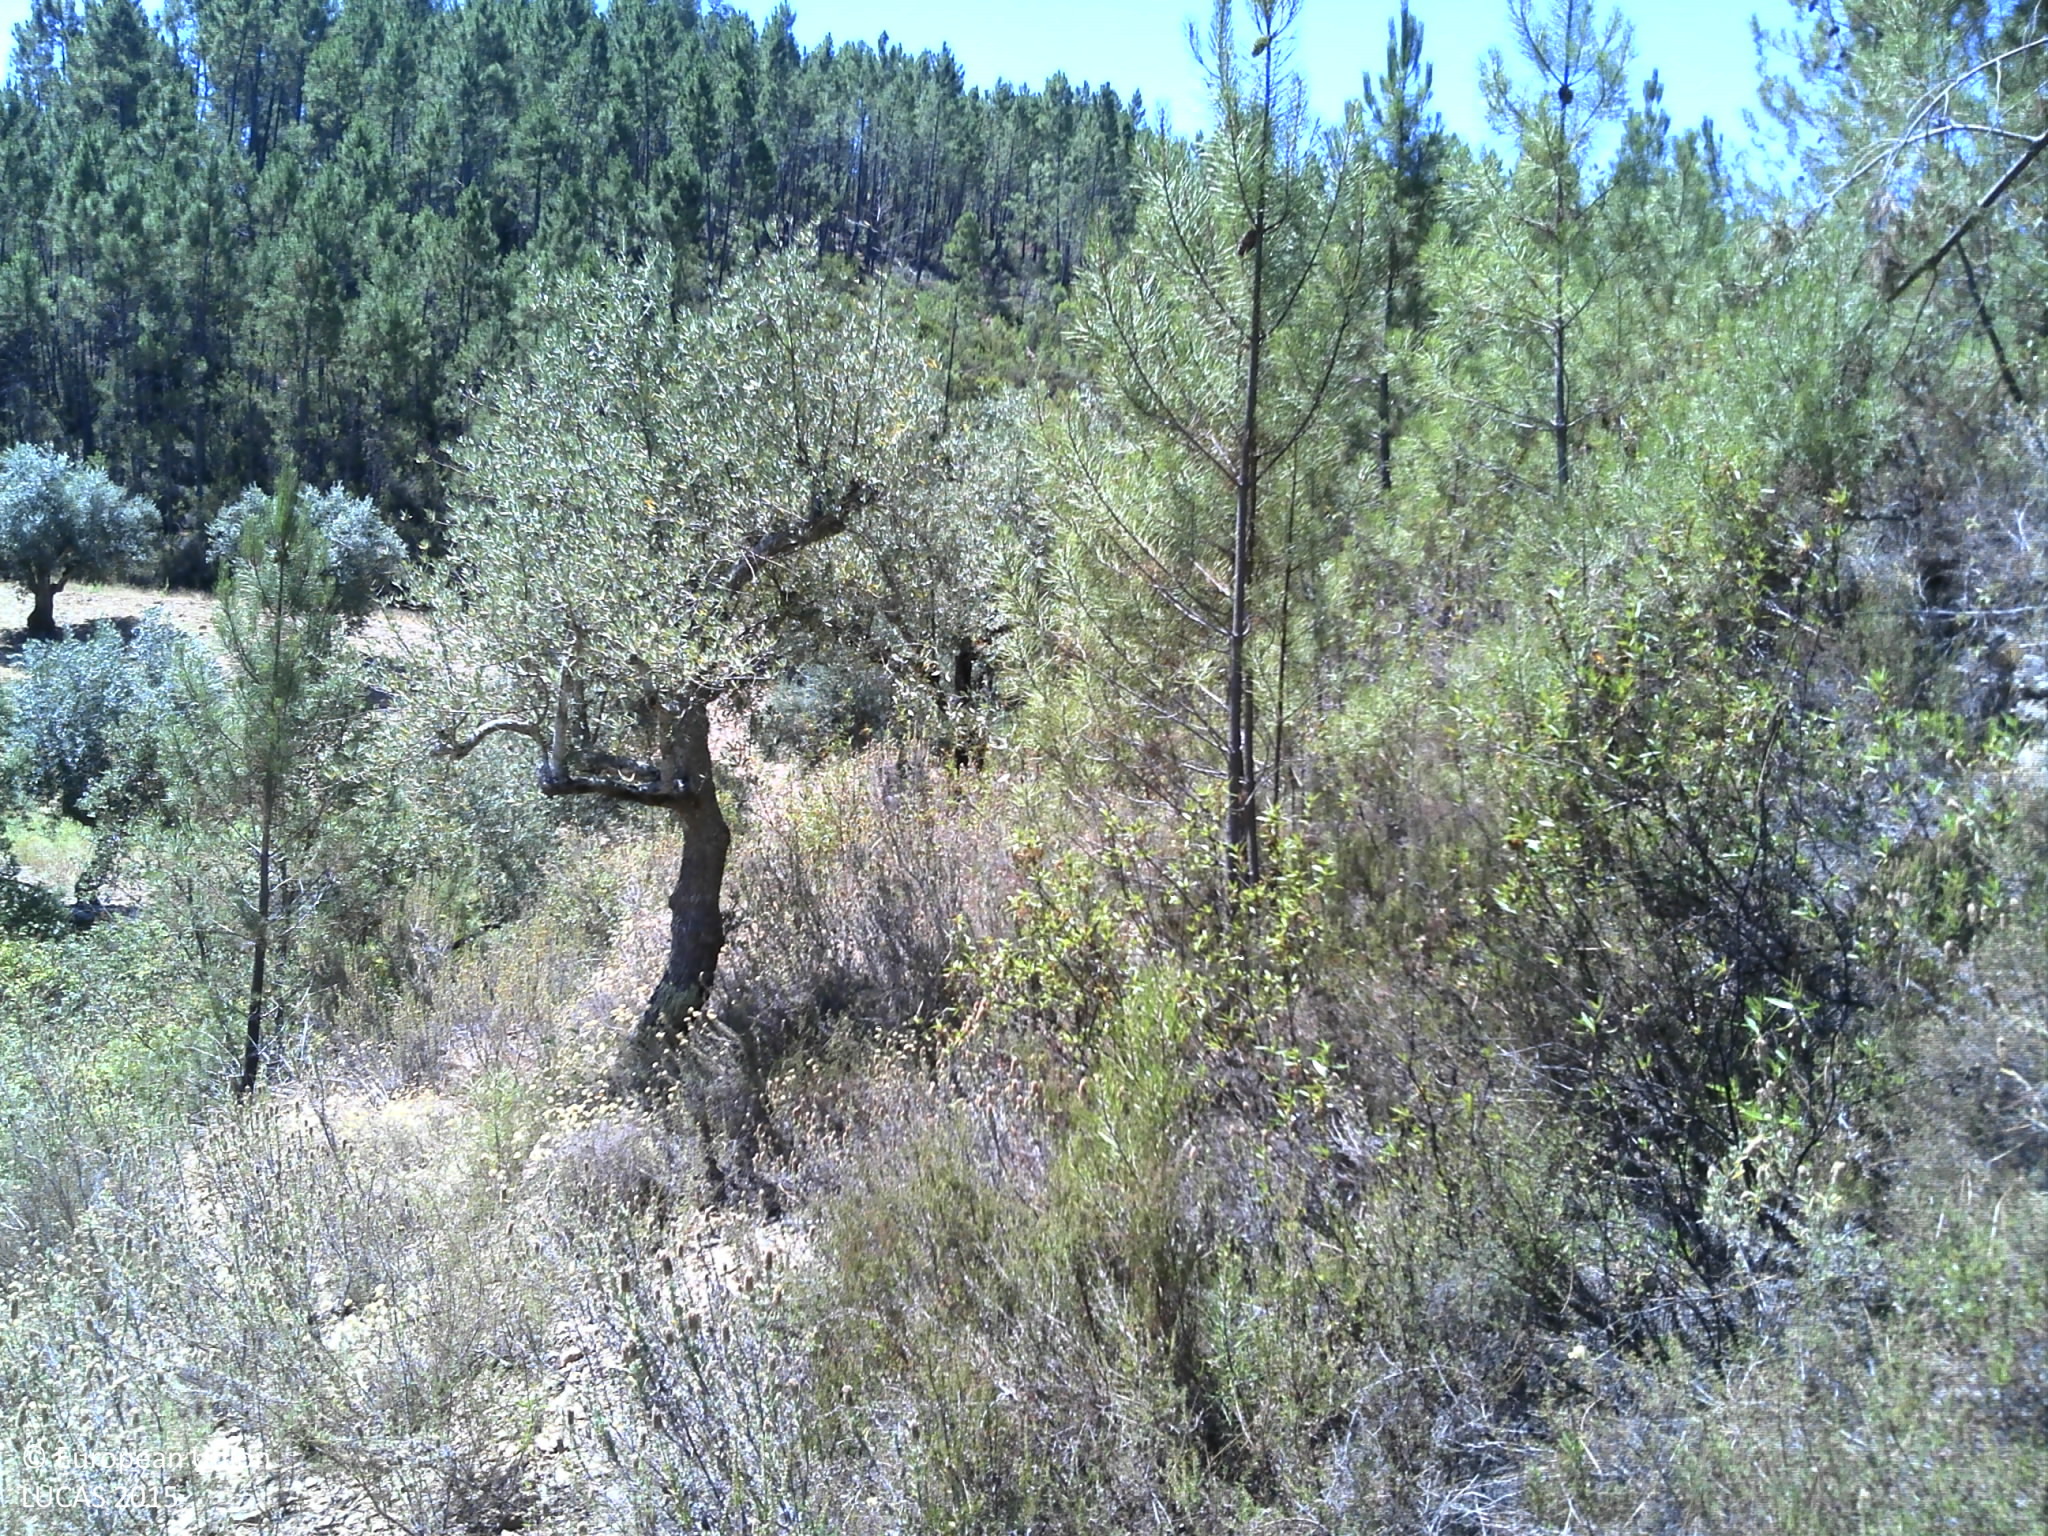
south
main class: Cropland
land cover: Olive groves
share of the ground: < 10 %
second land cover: Shrubland without tree cover
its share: > 75 %
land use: Abandoned areas
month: July
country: PT
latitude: 39.7146
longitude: -7.8003
